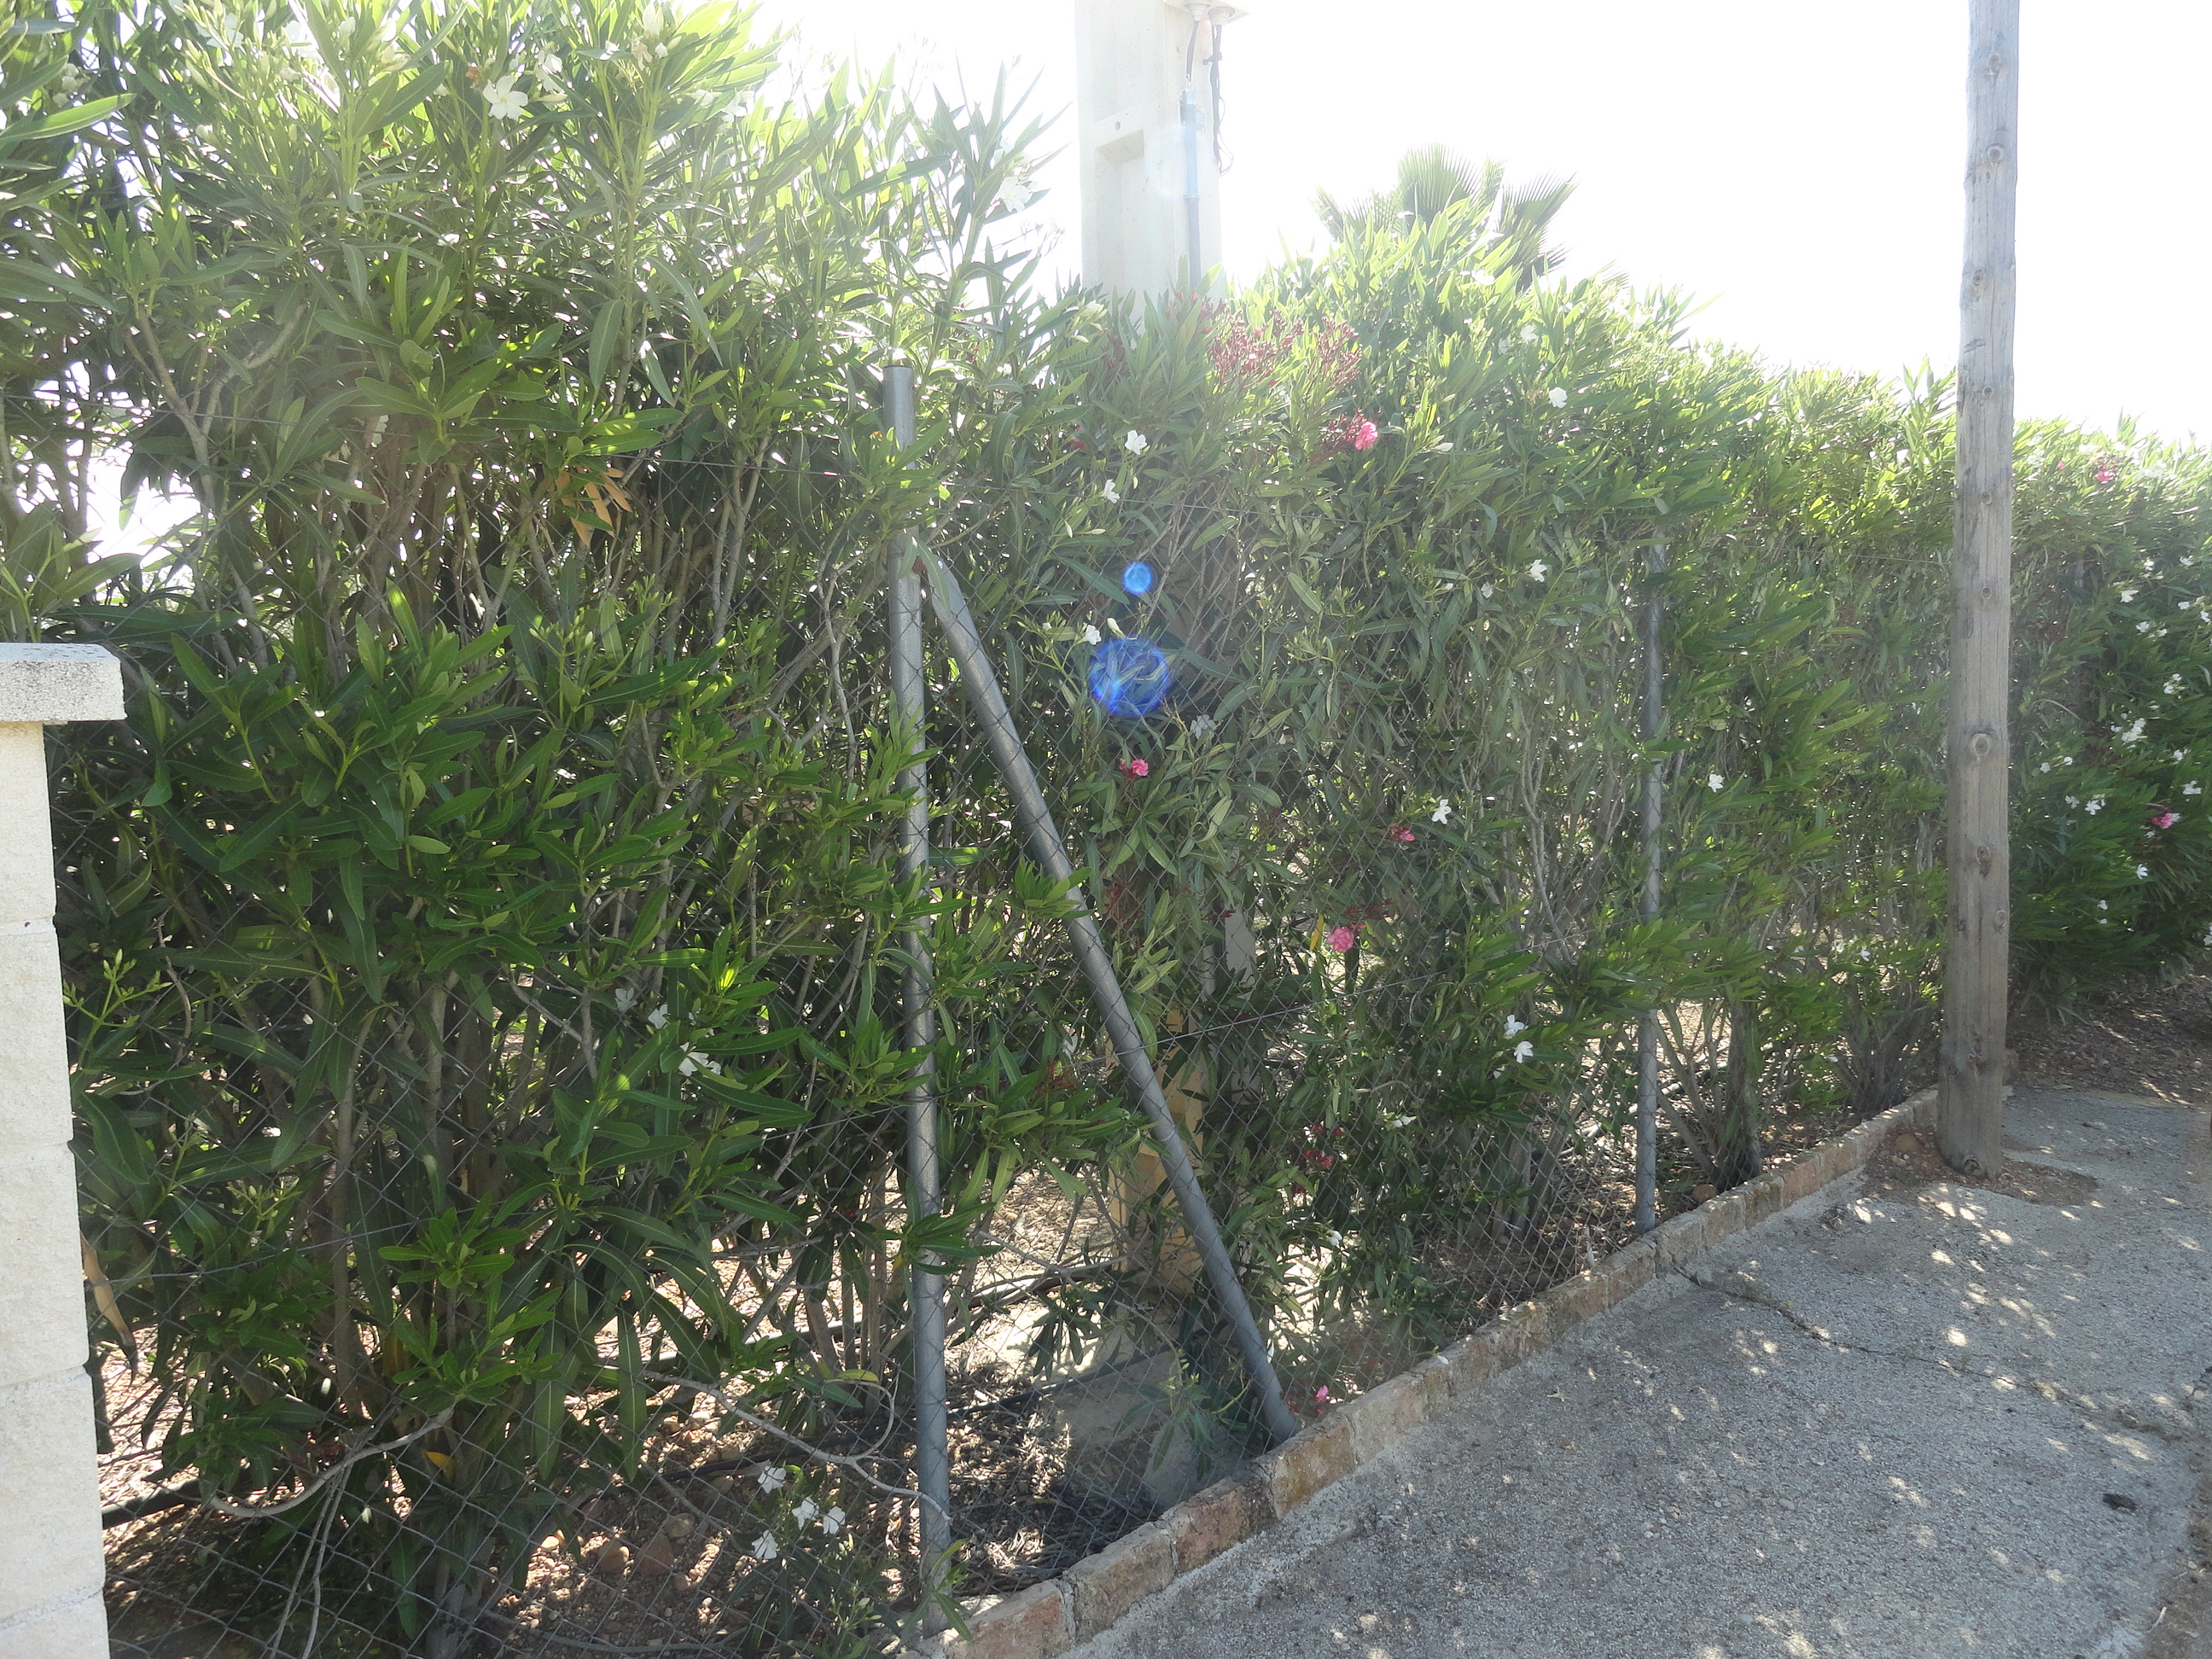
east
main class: Cropland
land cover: Olive groves
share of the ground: 10 - 25 %
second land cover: Other bare soil
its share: > 75 %
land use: Kitchen garden
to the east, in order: Olive groves; Other bare soil; Tracks; Artificial constructions in urban areas; Olive groves; Conifer hedges; Fences; Other bare soil; Fences; Spontaneously vegetated surfaces; Fences; Arable land (only in case pi); Ponds and wetlands; Arable land (only in case pi); Fences; Permanent crops (only in case pi)
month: May
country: ES
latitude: 37.7098
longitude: -4.8840
